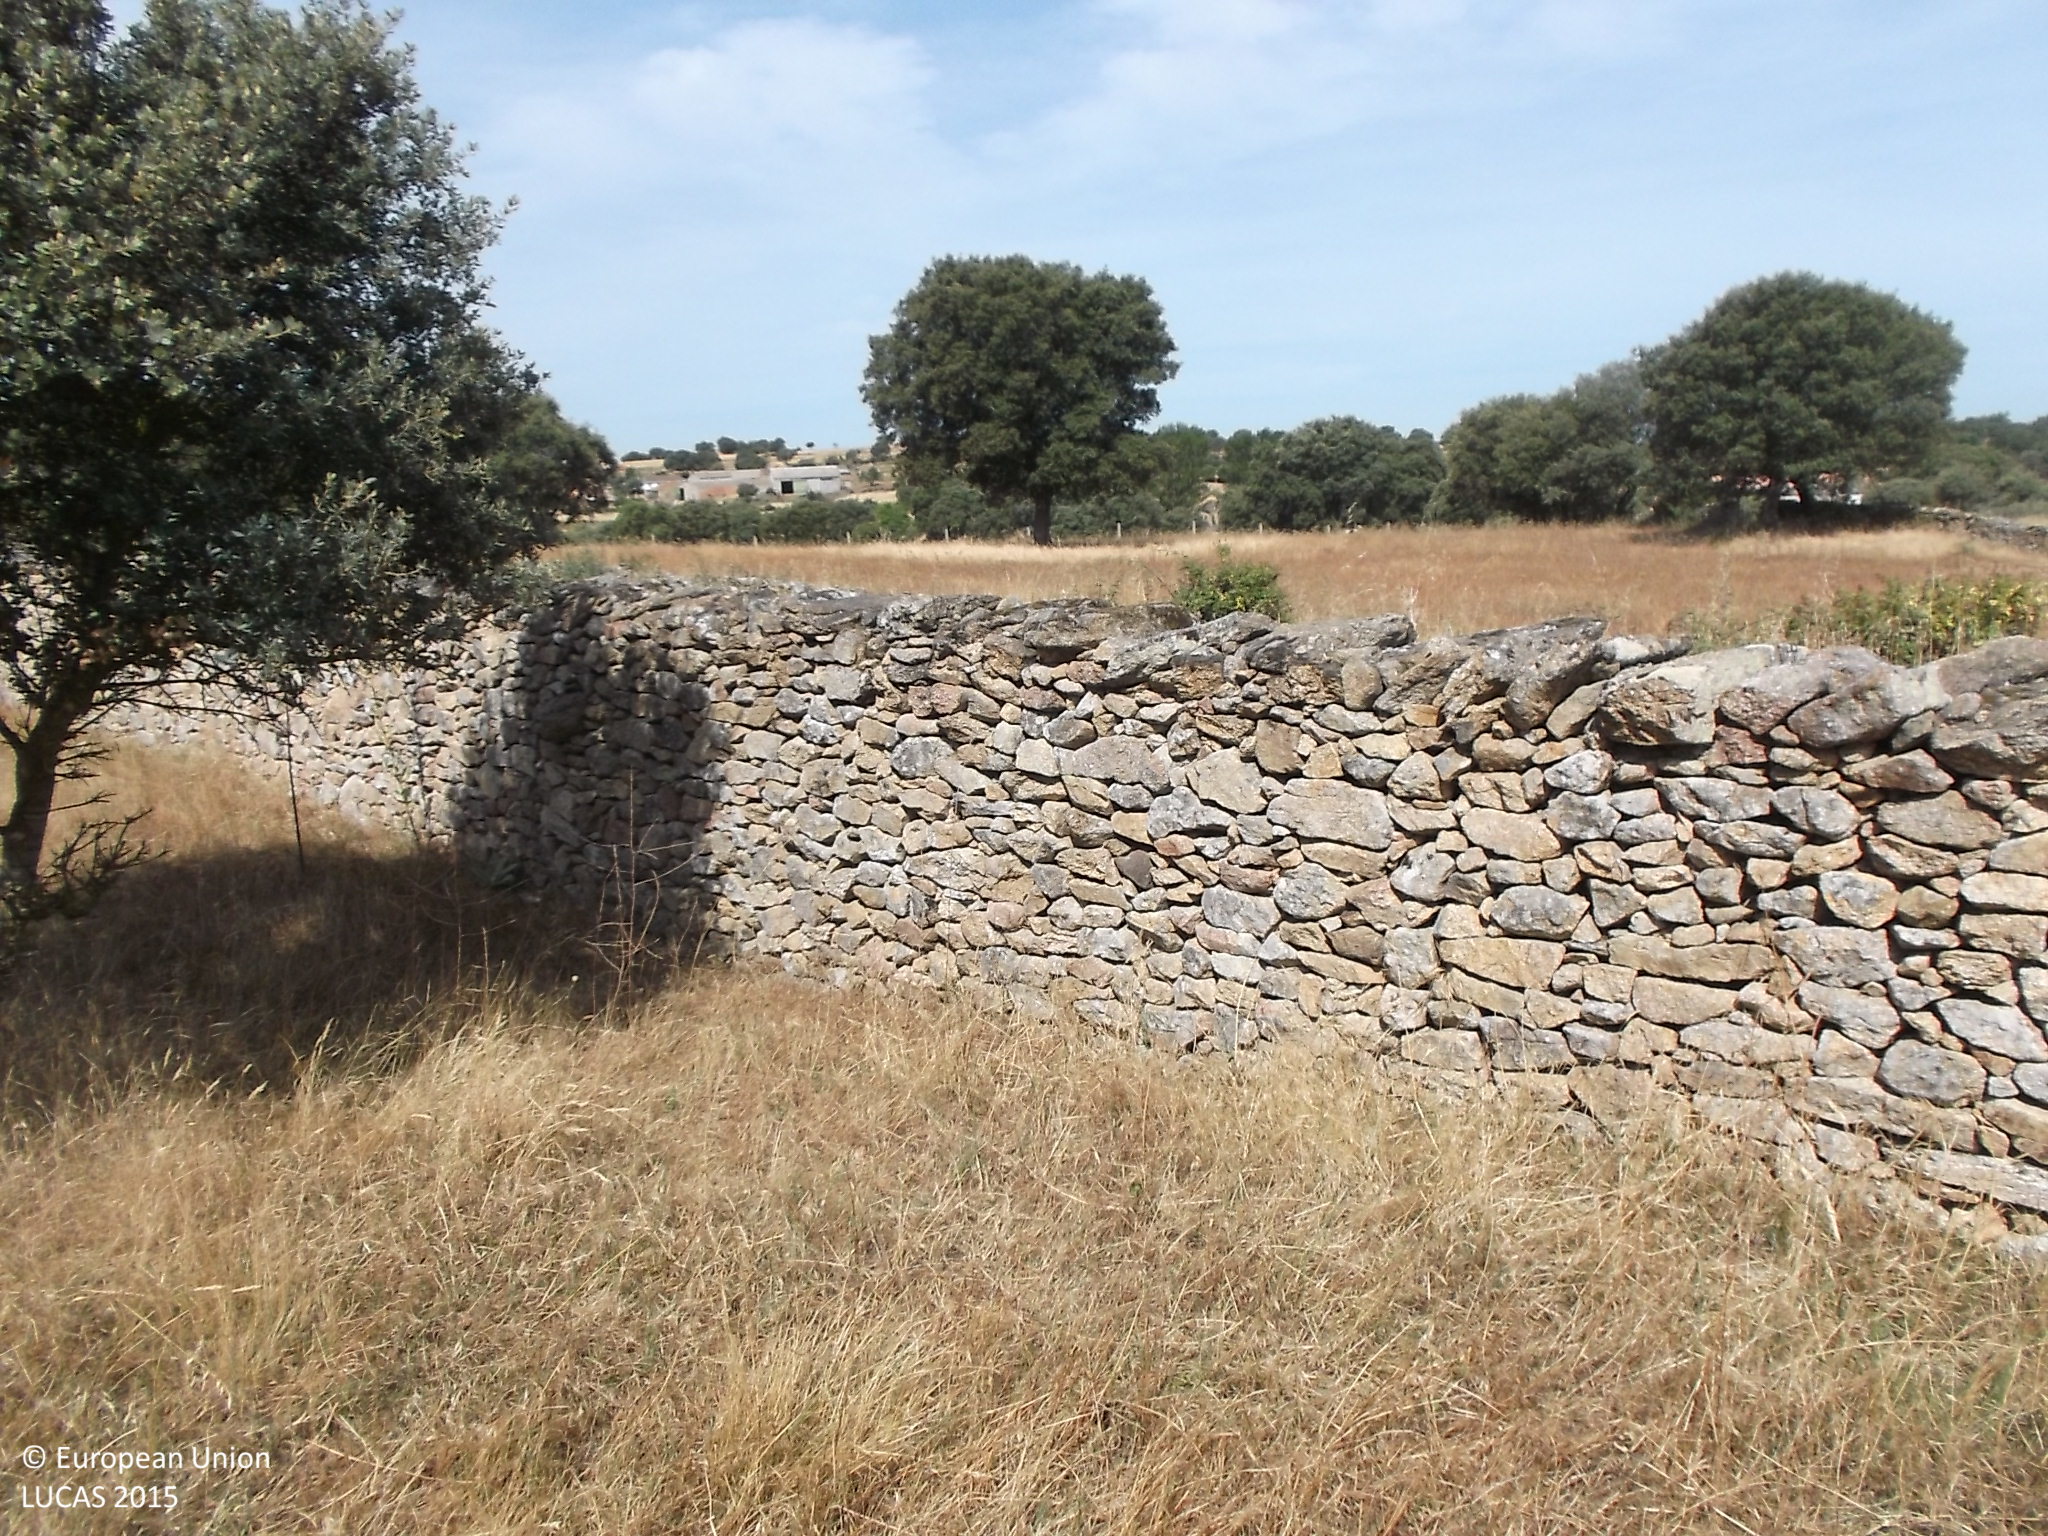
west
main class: Grassland
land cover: Grassland with sparse tree/shrub cover
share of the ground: > 75 %
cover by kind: herbaceous plants 90 %, broadleaved forest trees 5 %, shrubs 5 %
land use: Agriculture (excluding fallow land and kitchen gardens)
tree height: < 5 m
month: July
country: ES
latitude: 41.1773
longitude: -6.5127
